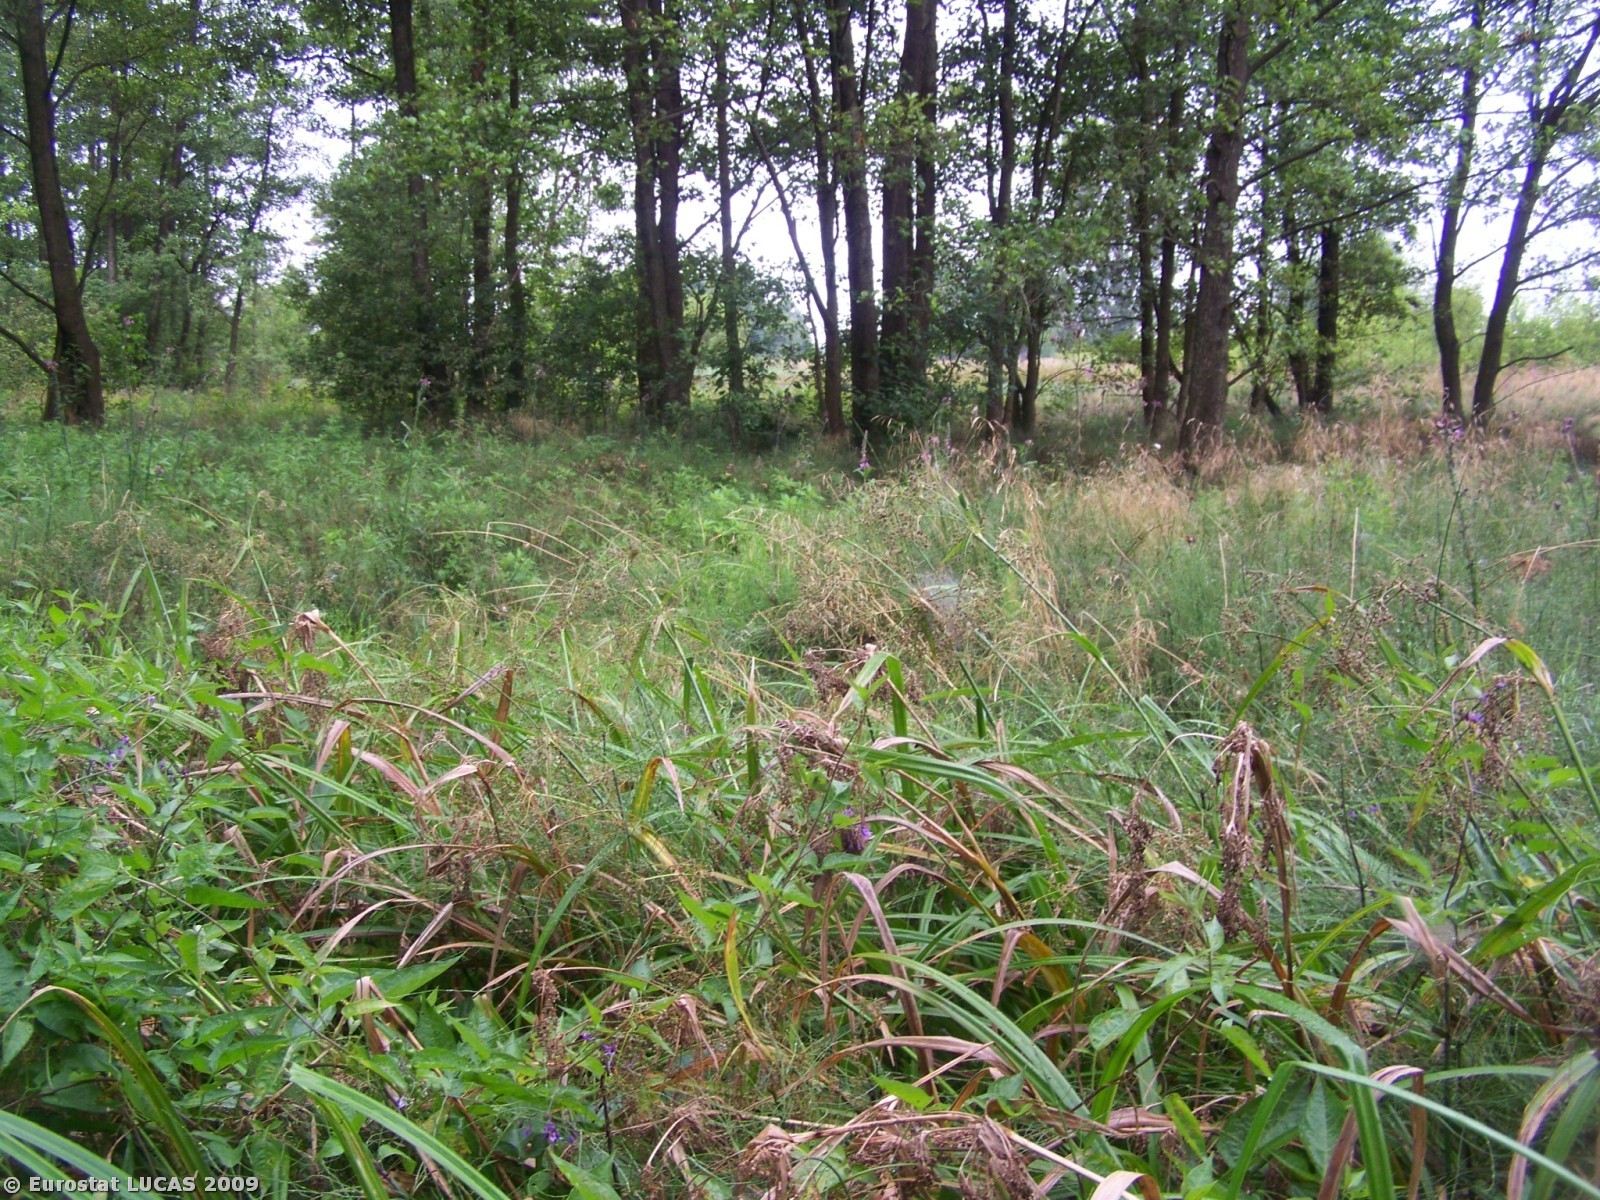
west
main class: Grassland
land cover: Spontaneously vegetated surfaces
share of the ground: > 75 %
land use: Forestry
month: July
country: PL
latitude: 51.5583
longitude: 22.0748
